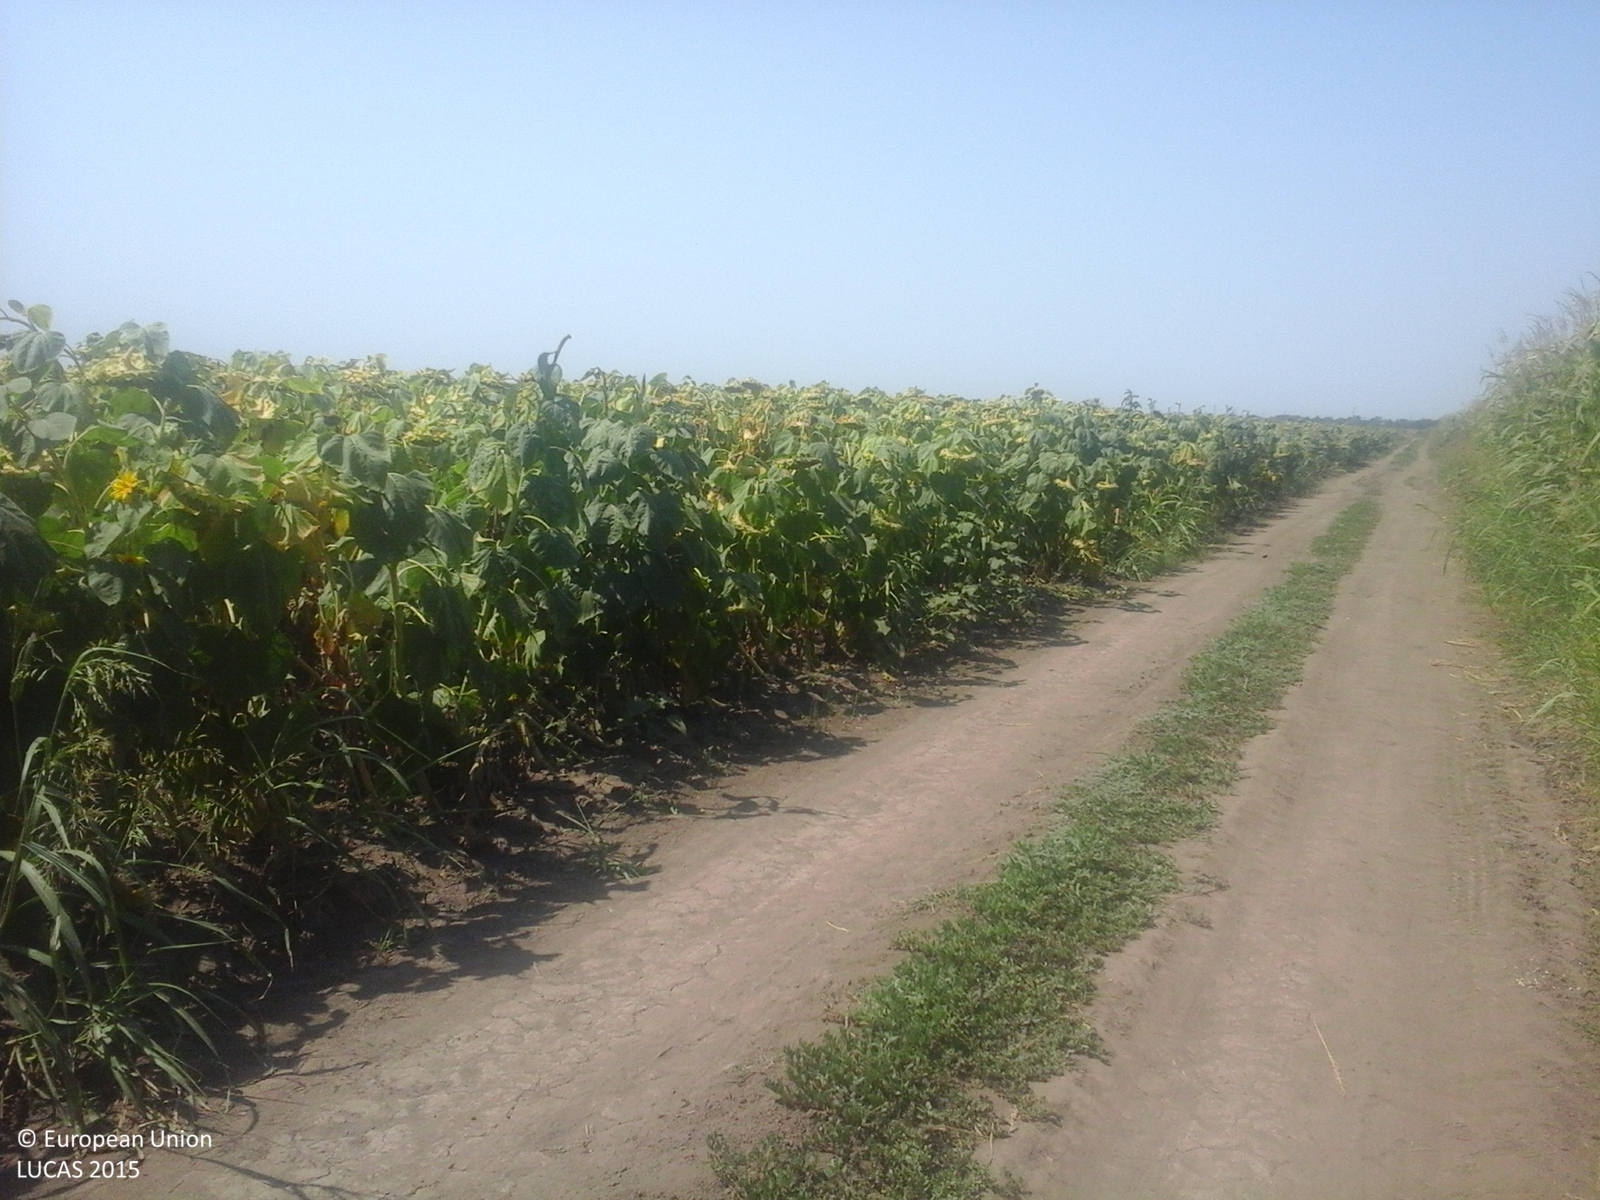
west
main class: Cropland
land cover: Maize
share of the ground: > 75 %
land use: Agriculture (excluding fallow land and kitchen gardens)
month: August
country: RO
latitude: 45.1418
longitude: 27.6665
